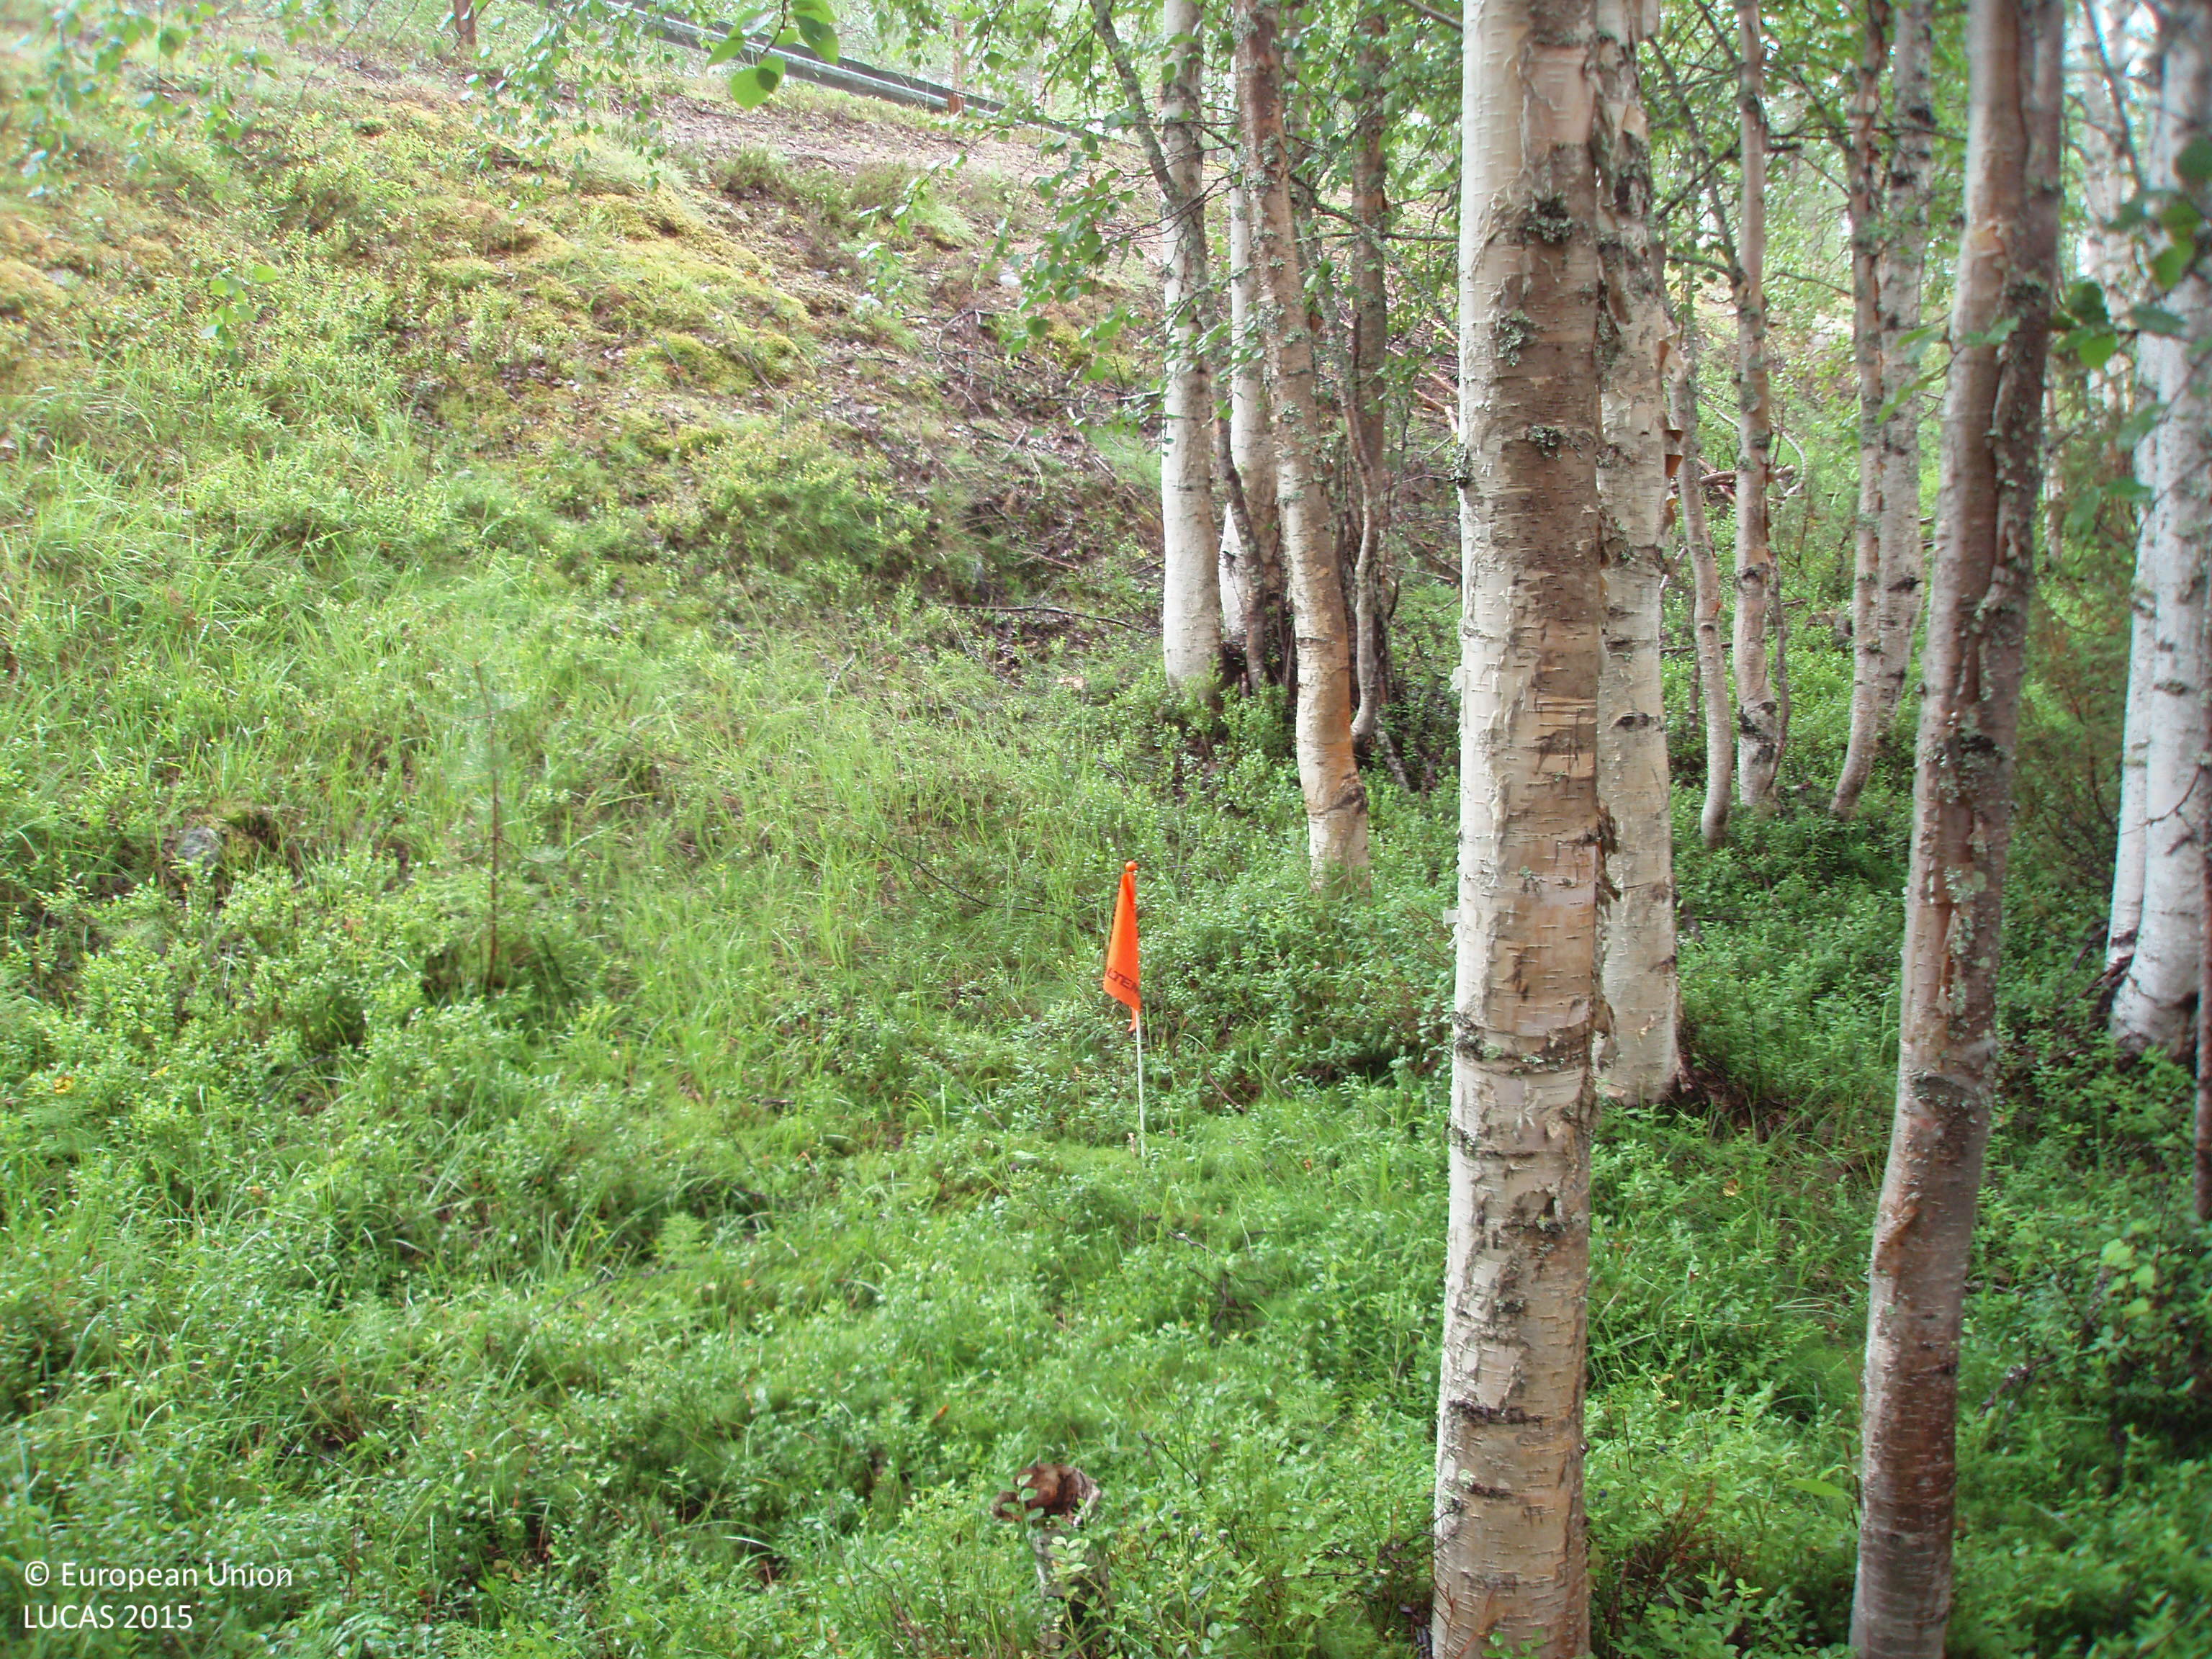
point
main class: Woodland
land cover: Broadleaved woodland
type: boreal forest
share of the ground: > 75 %
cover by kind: broadleaved forest trees 85 %, shrubs 10 %, coniferous forest trees 5 %
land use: Forestry
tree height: > 5 m
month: August
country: FI
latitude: 65.5879
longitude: 27.5416
